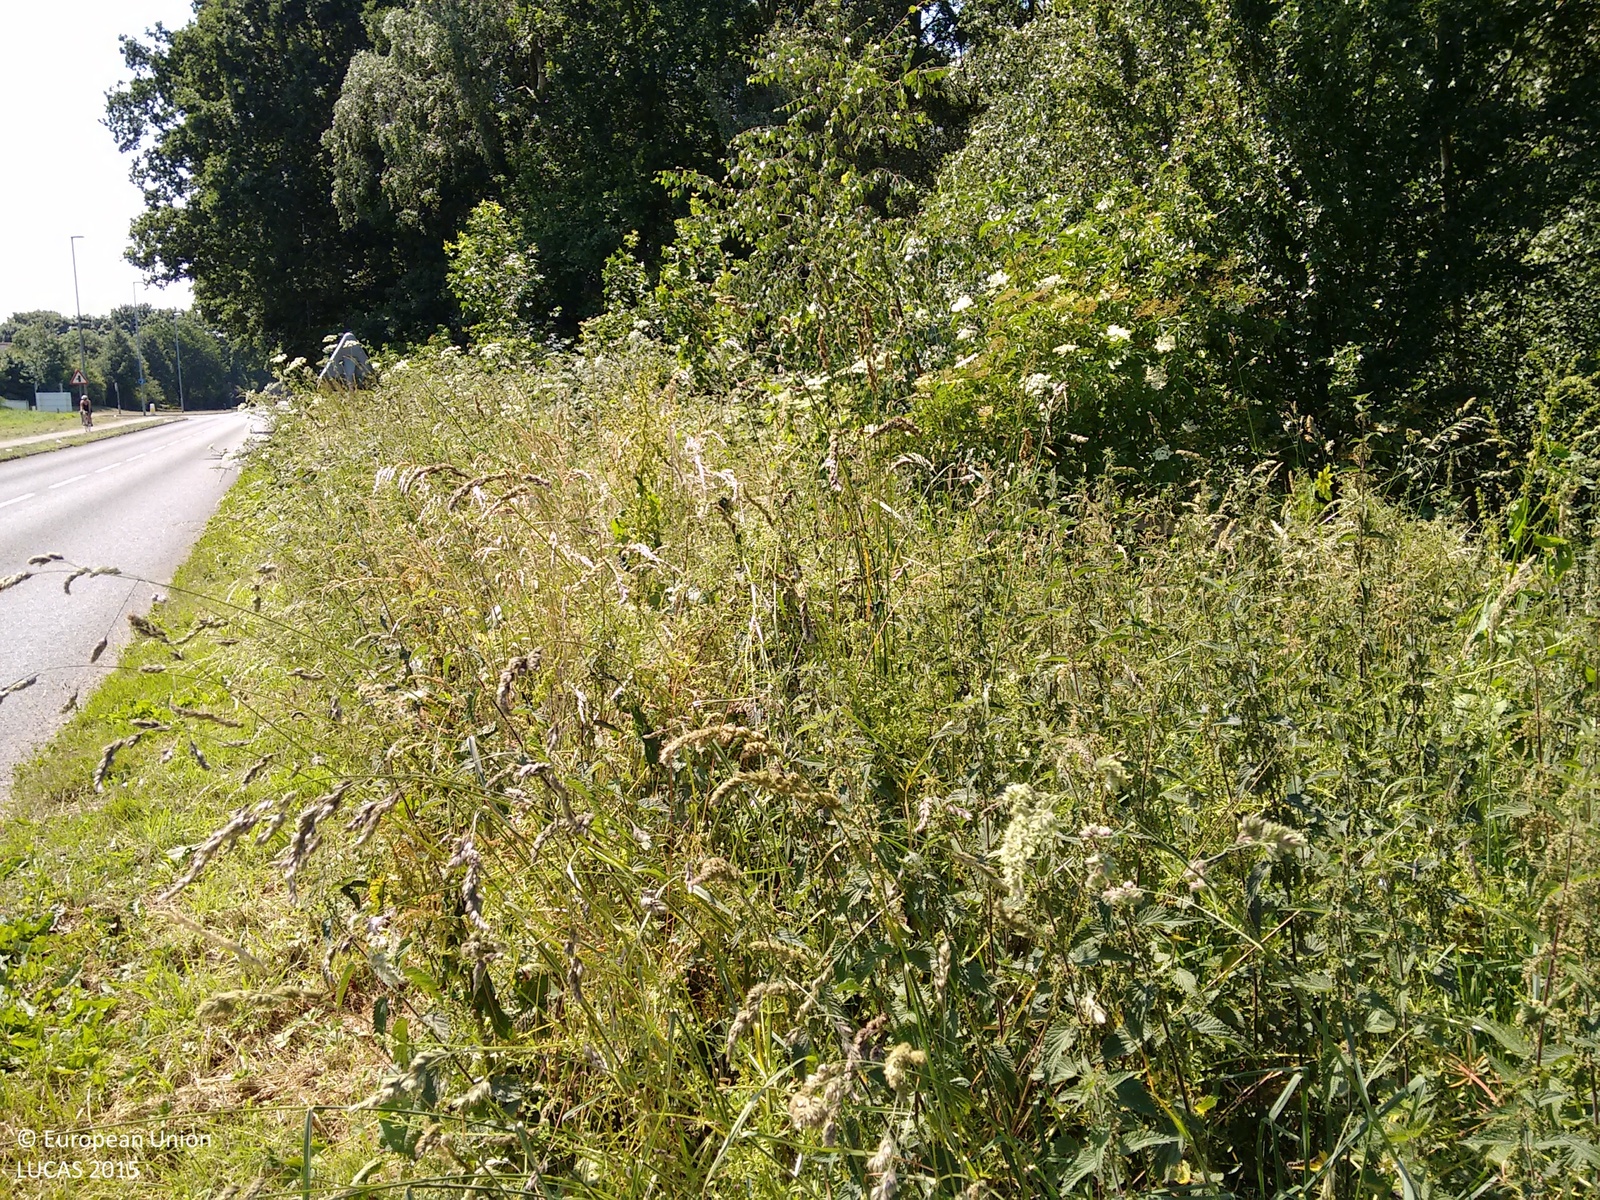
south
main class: Woodland
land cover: Broadleaved woodland
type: mesophytic deciduous forest
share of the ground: > 75 %
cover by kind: broadleaved forest trees 90 %, coniferous forest trees 5 %, shrubs 5 %
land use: Semi-natural and natural areas not in use
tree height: > 5 m
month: July
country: GB
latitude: 53.1468
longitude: -0.6701
